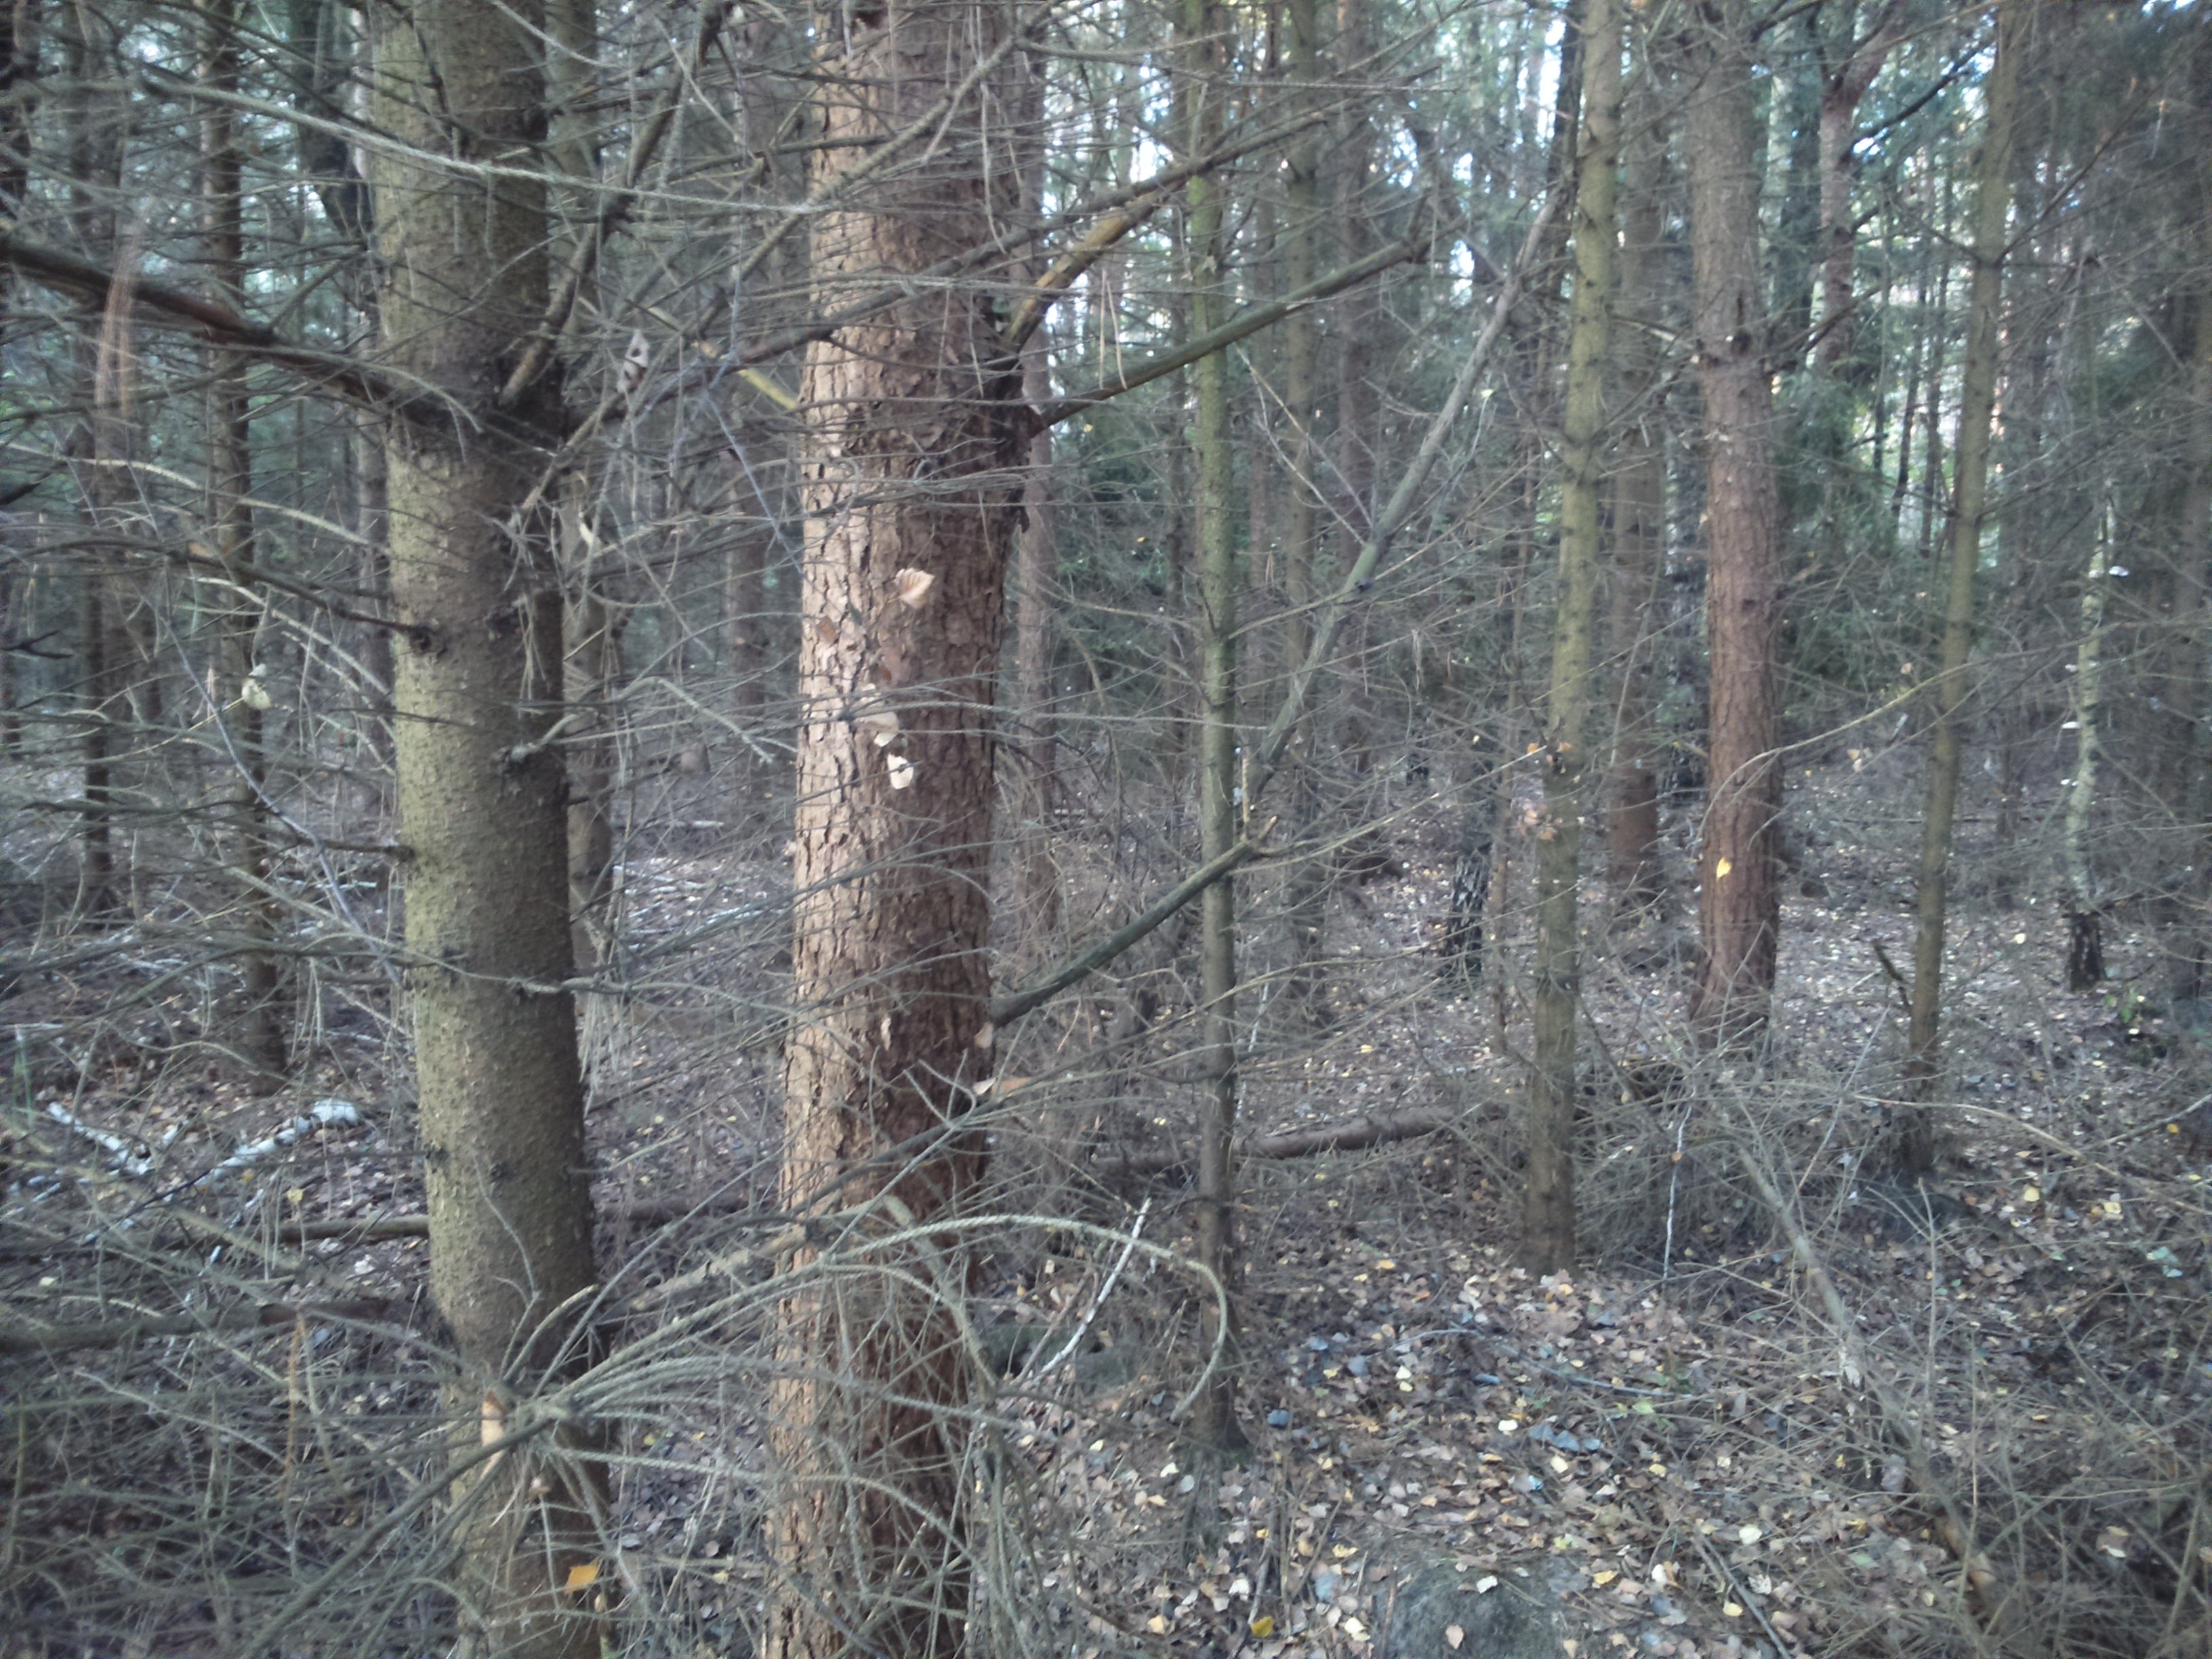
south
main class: Woodland
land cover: Spruce dominated mixed woodland
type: hemiboreal forest and nemoral coniferous forest and mixed broadleaved-coniferous forest
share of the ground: > 75 %
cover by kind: coniferous forest trees 75 %, broadleaved forest trees 25 %
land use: Forestry
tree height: > 5 m
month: September
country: PL
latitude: 52.5166
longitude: 22.1293
